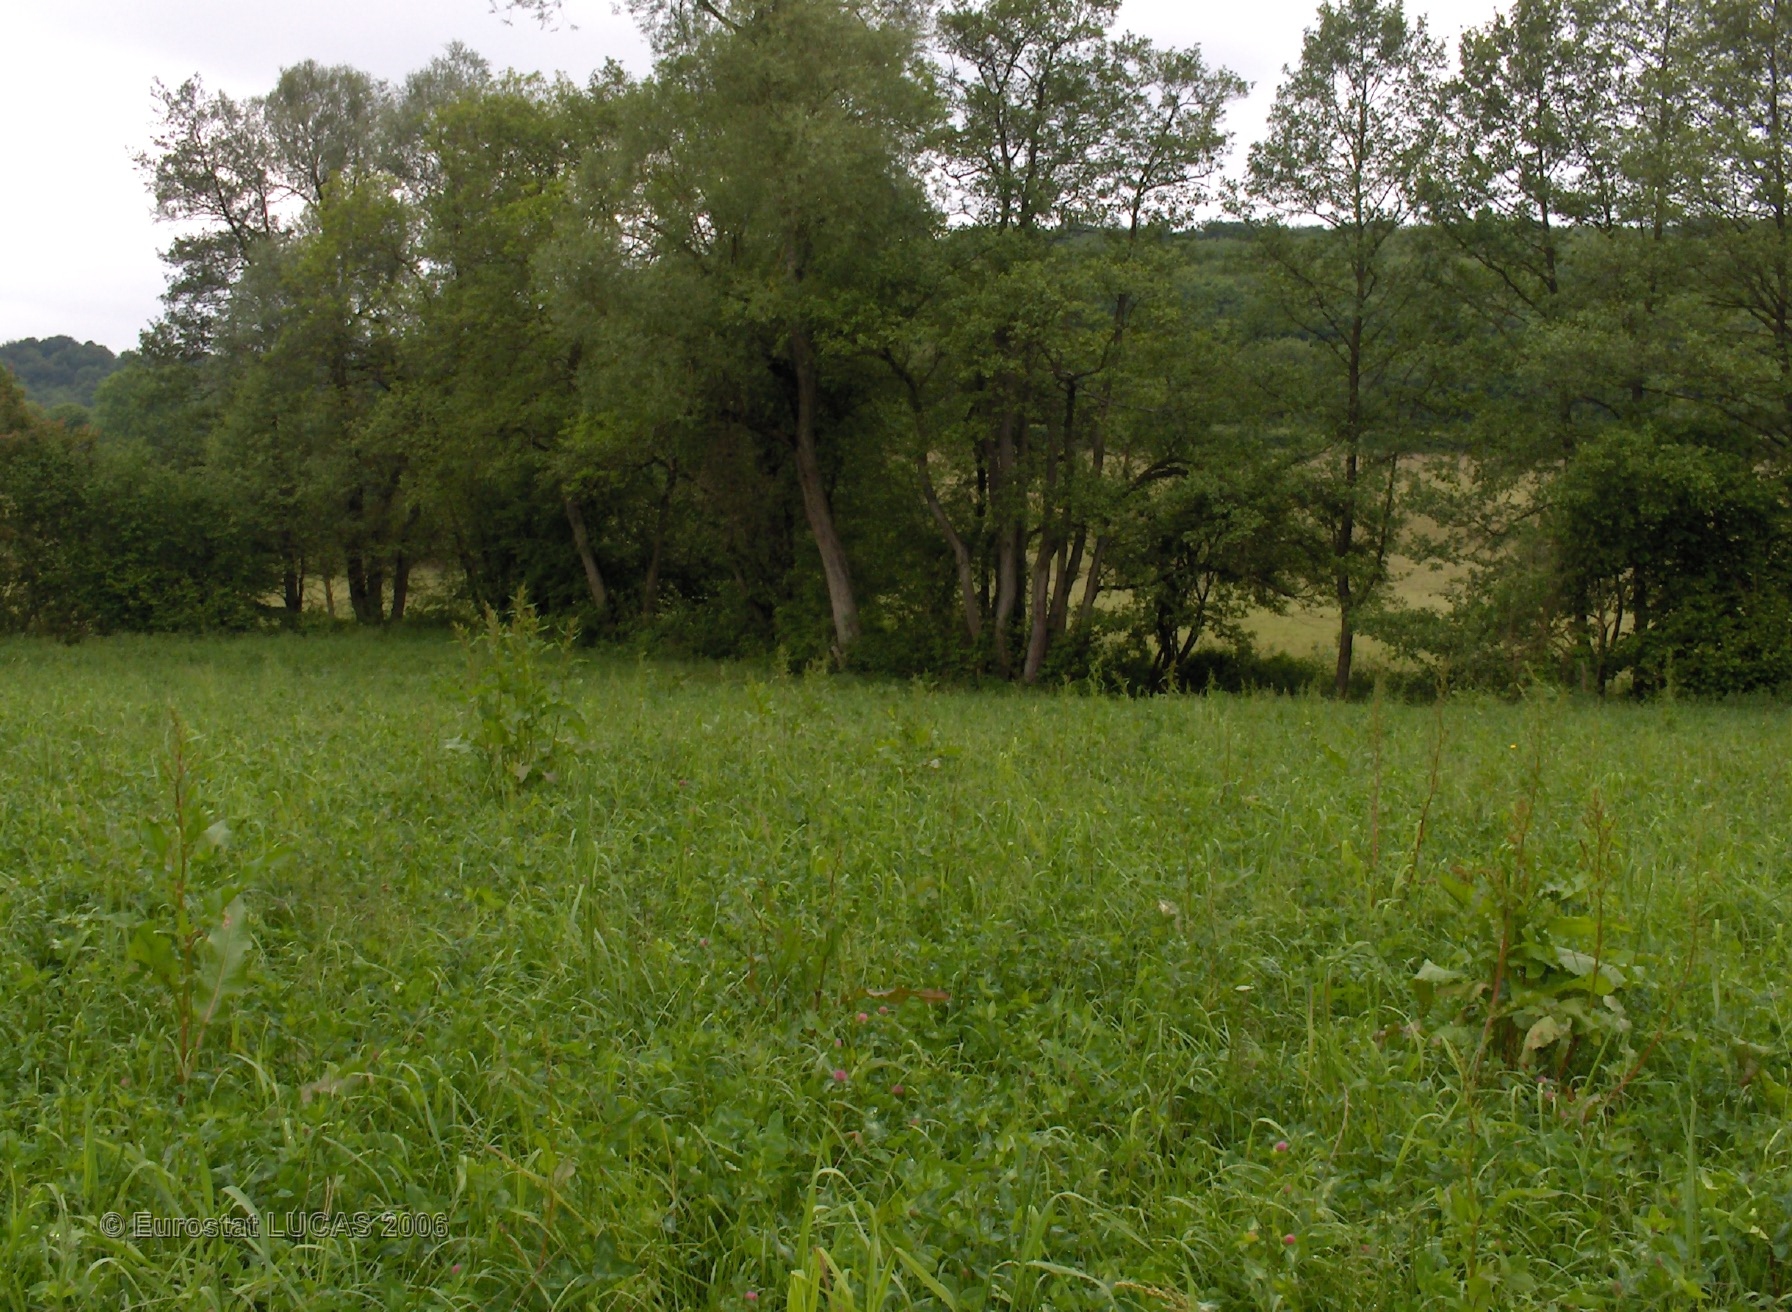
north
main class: Grassland
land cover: Grassland without tree/shrub cover
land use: Agriculture (excluding fallow land and kitchen gardens)
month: June
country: BE
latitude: 50.1634
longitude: 4.5786
